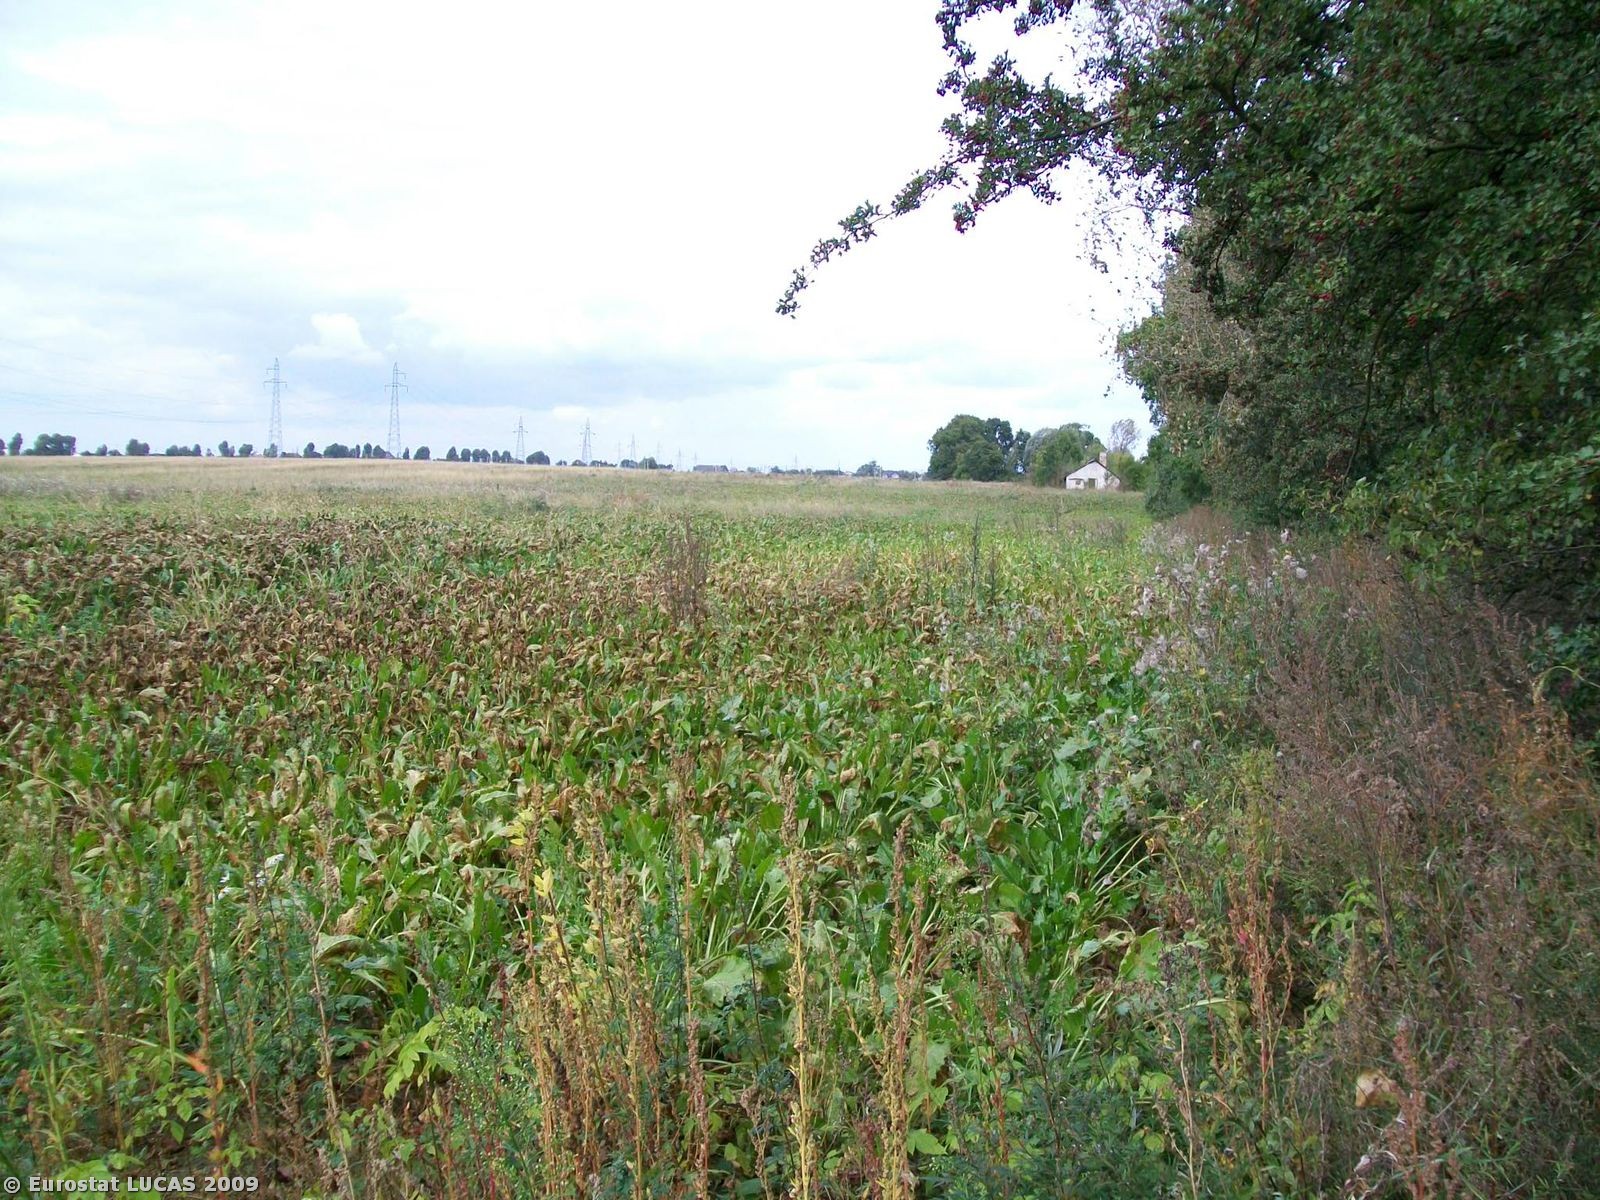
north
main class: Cropland
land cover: Sugar beet
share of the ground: > 75 %
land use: Agriculture (excluding fallow land and kitchen gardens)
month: September
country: PL
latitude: 52.1975
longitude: 20.7359
